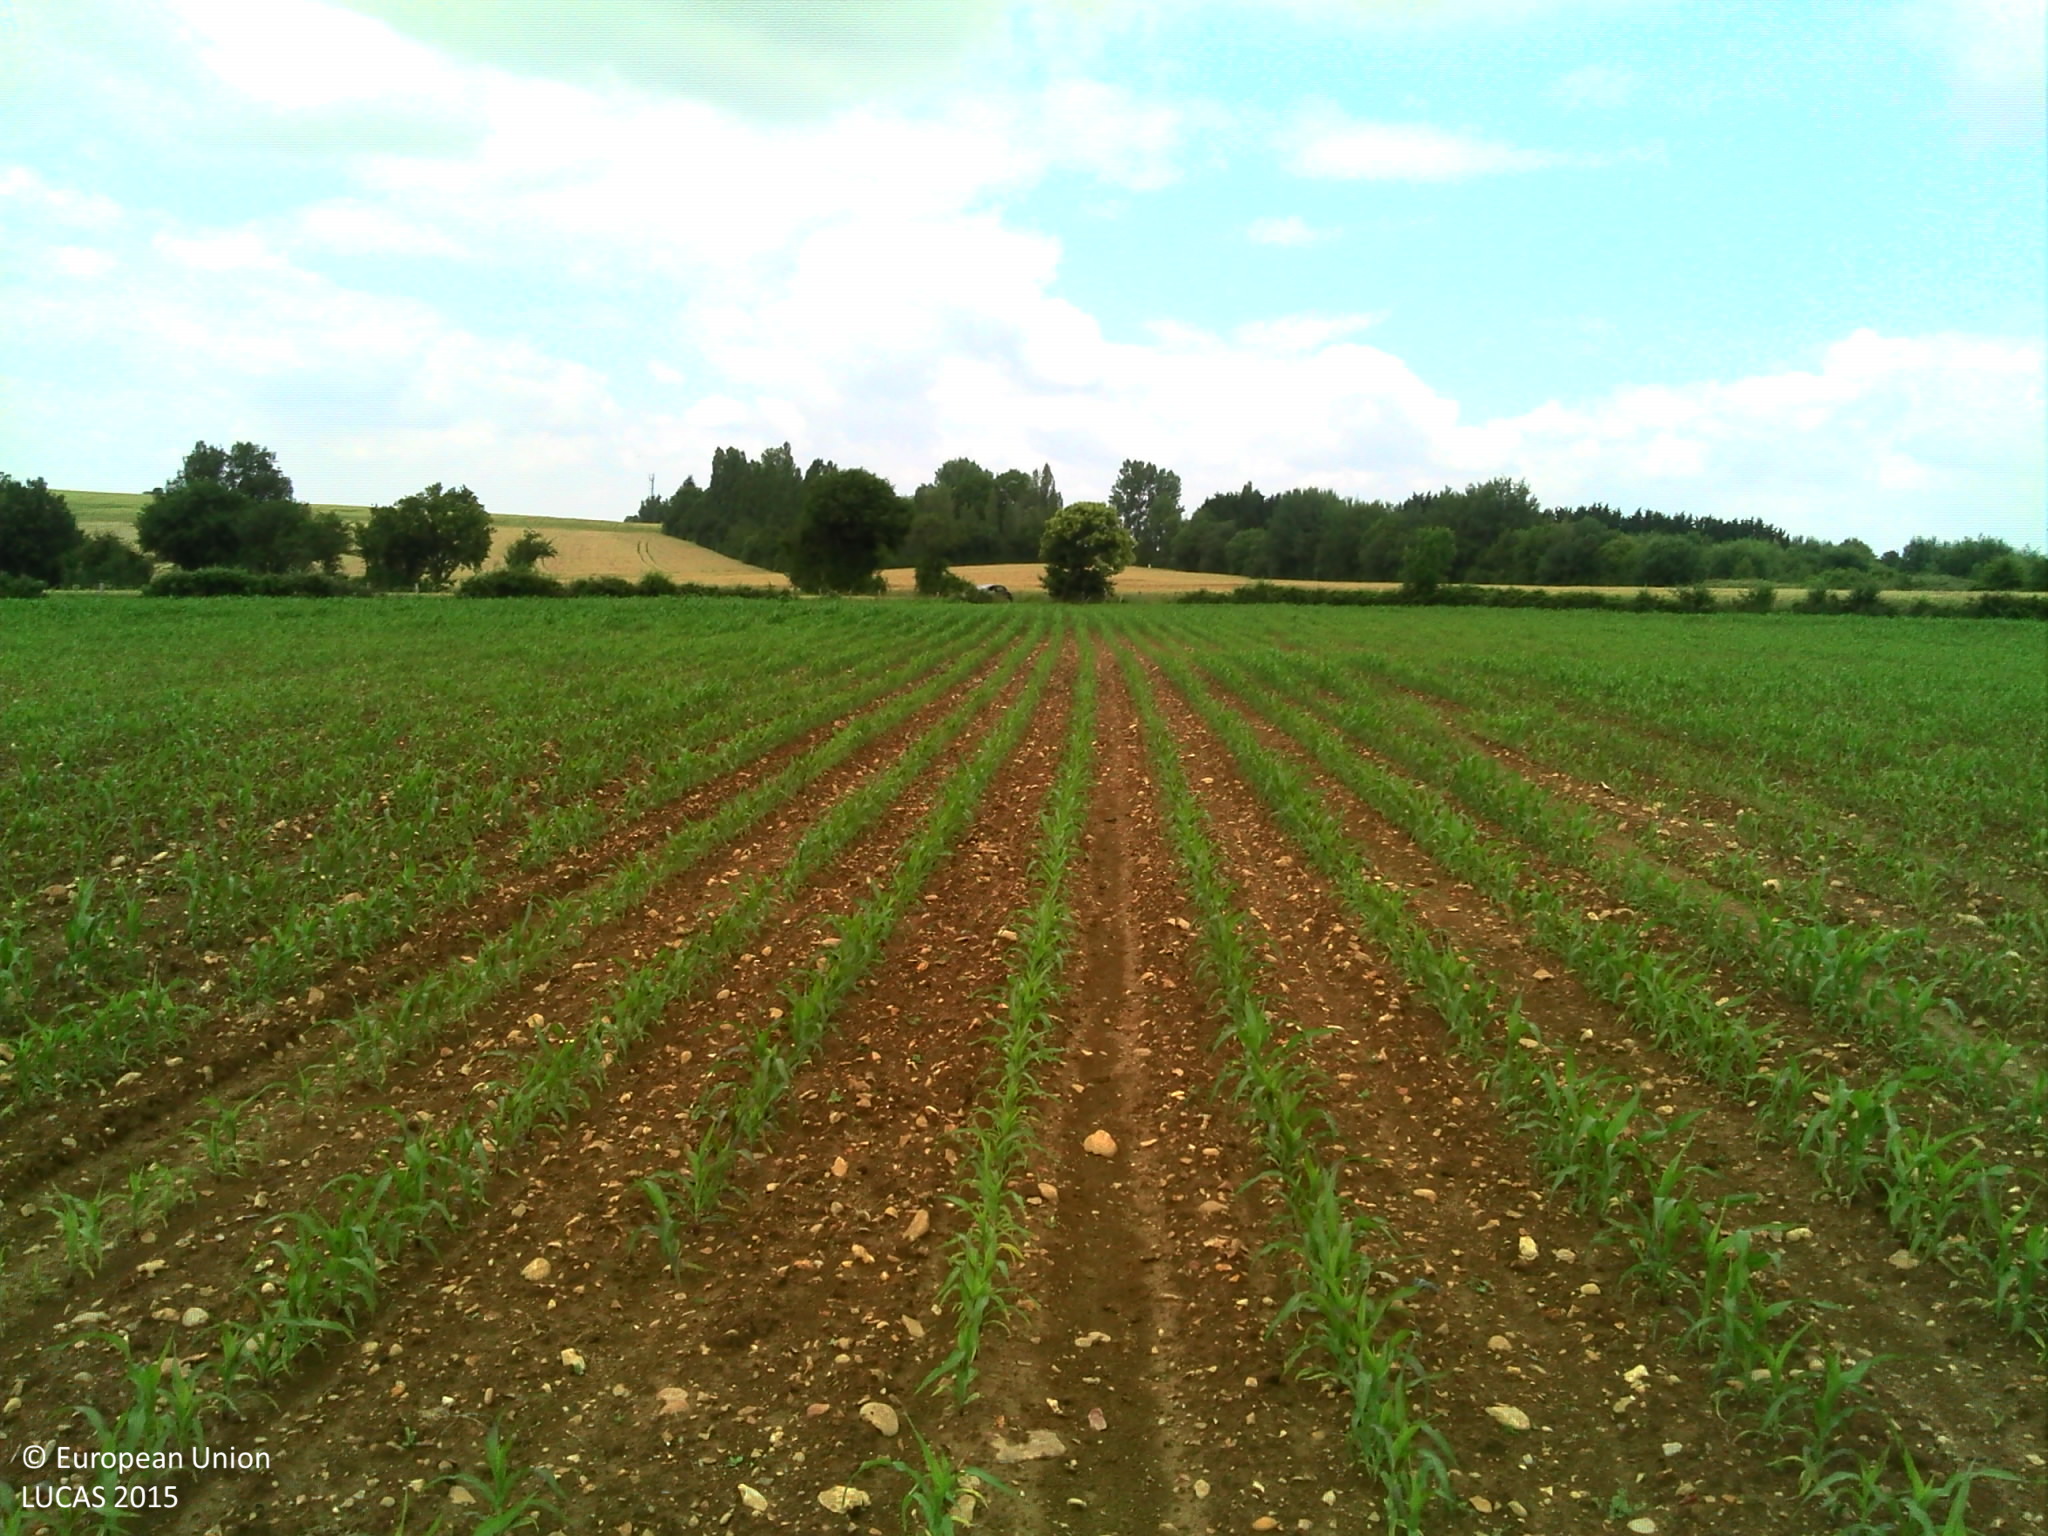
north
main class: Cropland
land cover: Maize
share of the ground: 10 - 25 %
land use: Agriculture (excluding fallow land and kitchen gardens)
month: June
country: FR
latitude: 47.4839
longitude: 3.1070
